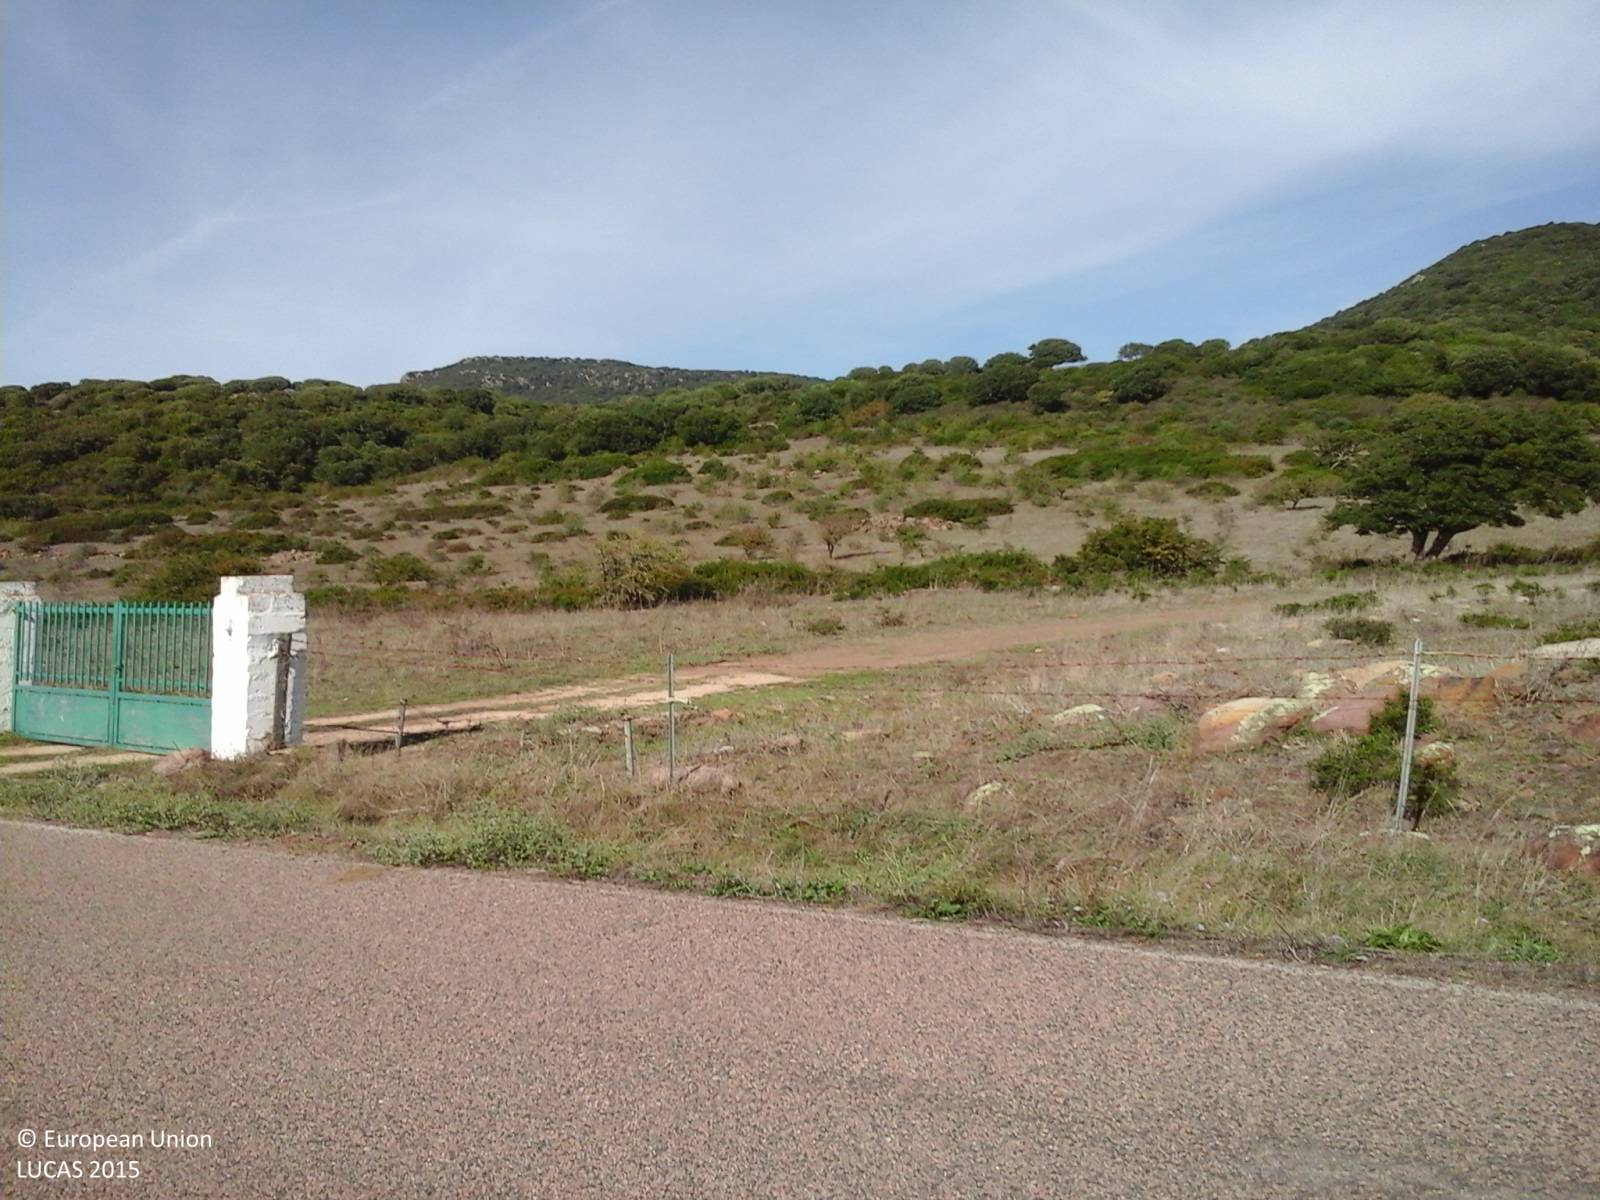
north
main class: Grassland
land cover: Grassland without tree/shrub cover
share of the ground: > 75 %
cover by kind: herbaceous plants 100 %
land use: Agriculture (excluding fallow land and kitchen gardens)
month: October
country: IT
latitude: 40.4193
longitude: 8.5342
